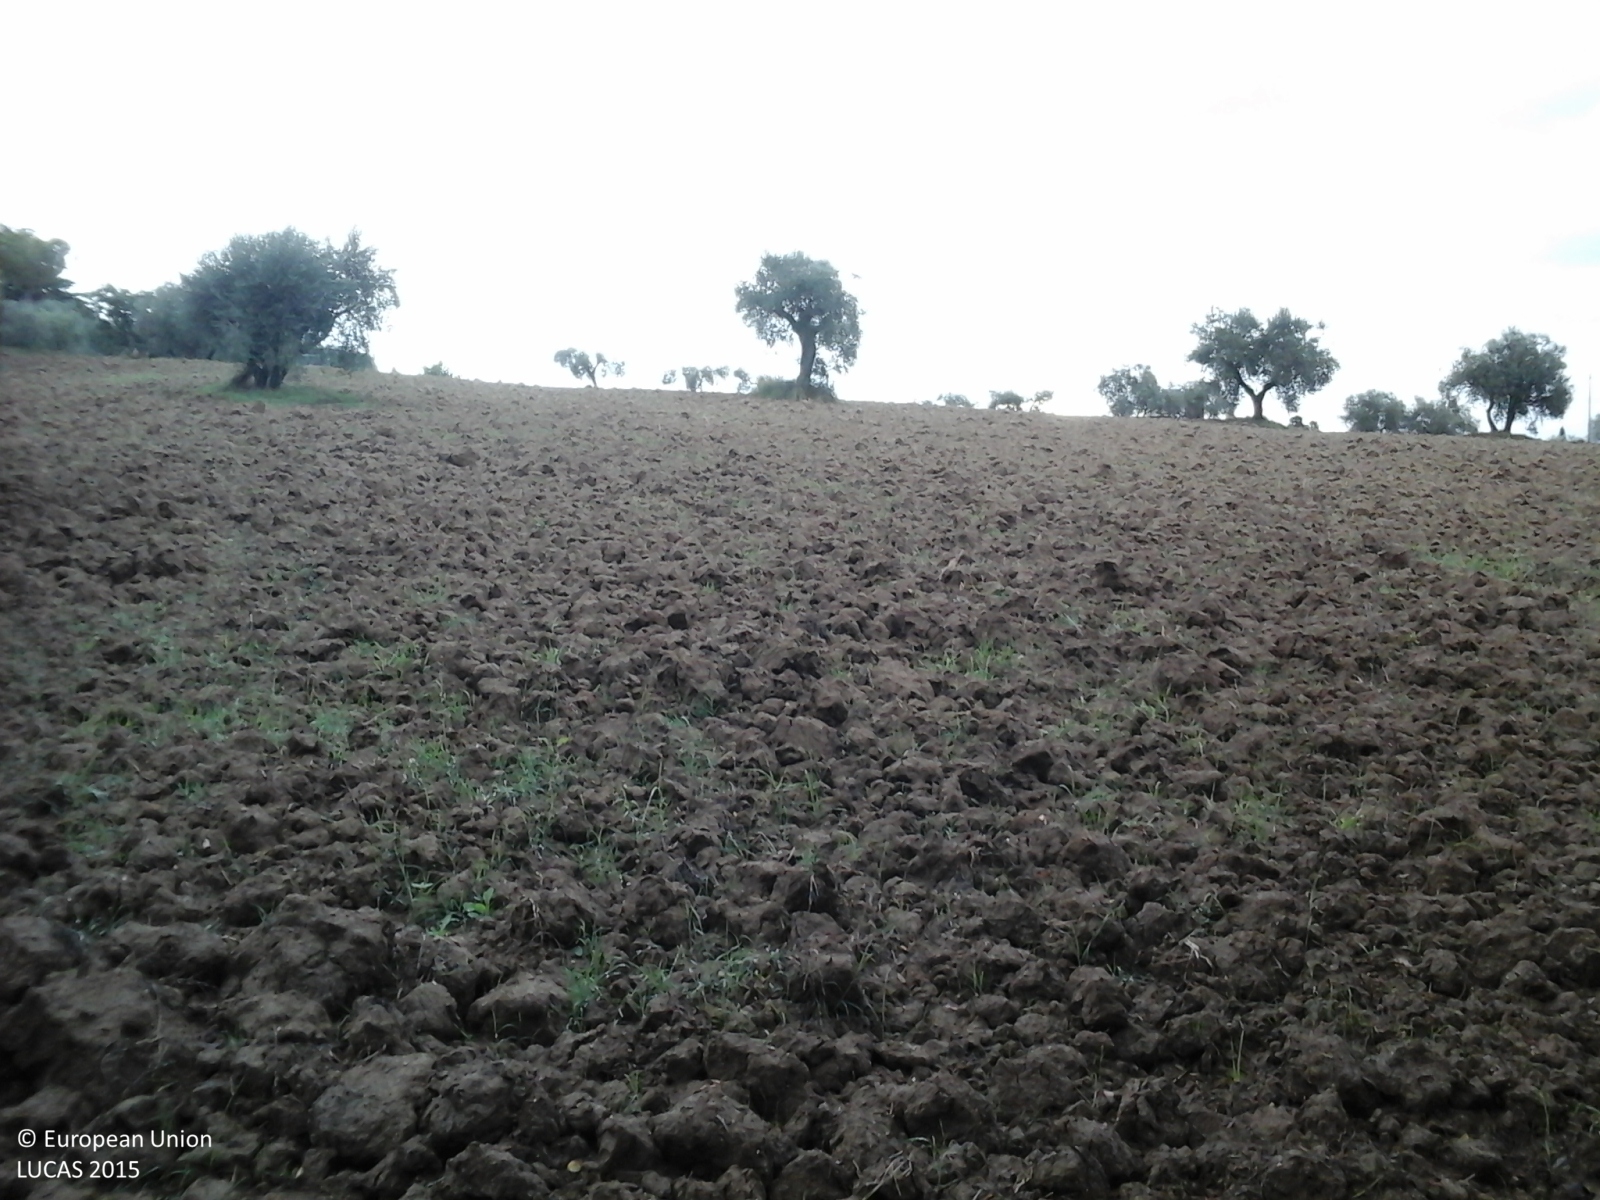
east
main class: Cropland
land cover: Durum wheat
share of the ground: < 10 %
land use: Agriculture (excluding fallow land and kitchen gardens)
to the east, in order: Durum wheat; Single bushes/trees; Durum wheat; Lines of trees; Grass margins; Tracks; Grass margins; Other bare soil; Electric lines; Other bare soil; Grass margins; Electric lines; Fences; Olive groves; Fences; Tracks; Ditches and canals; Abandoned hedges
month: October
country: IT
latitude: 43.7060
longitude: 13.1818
